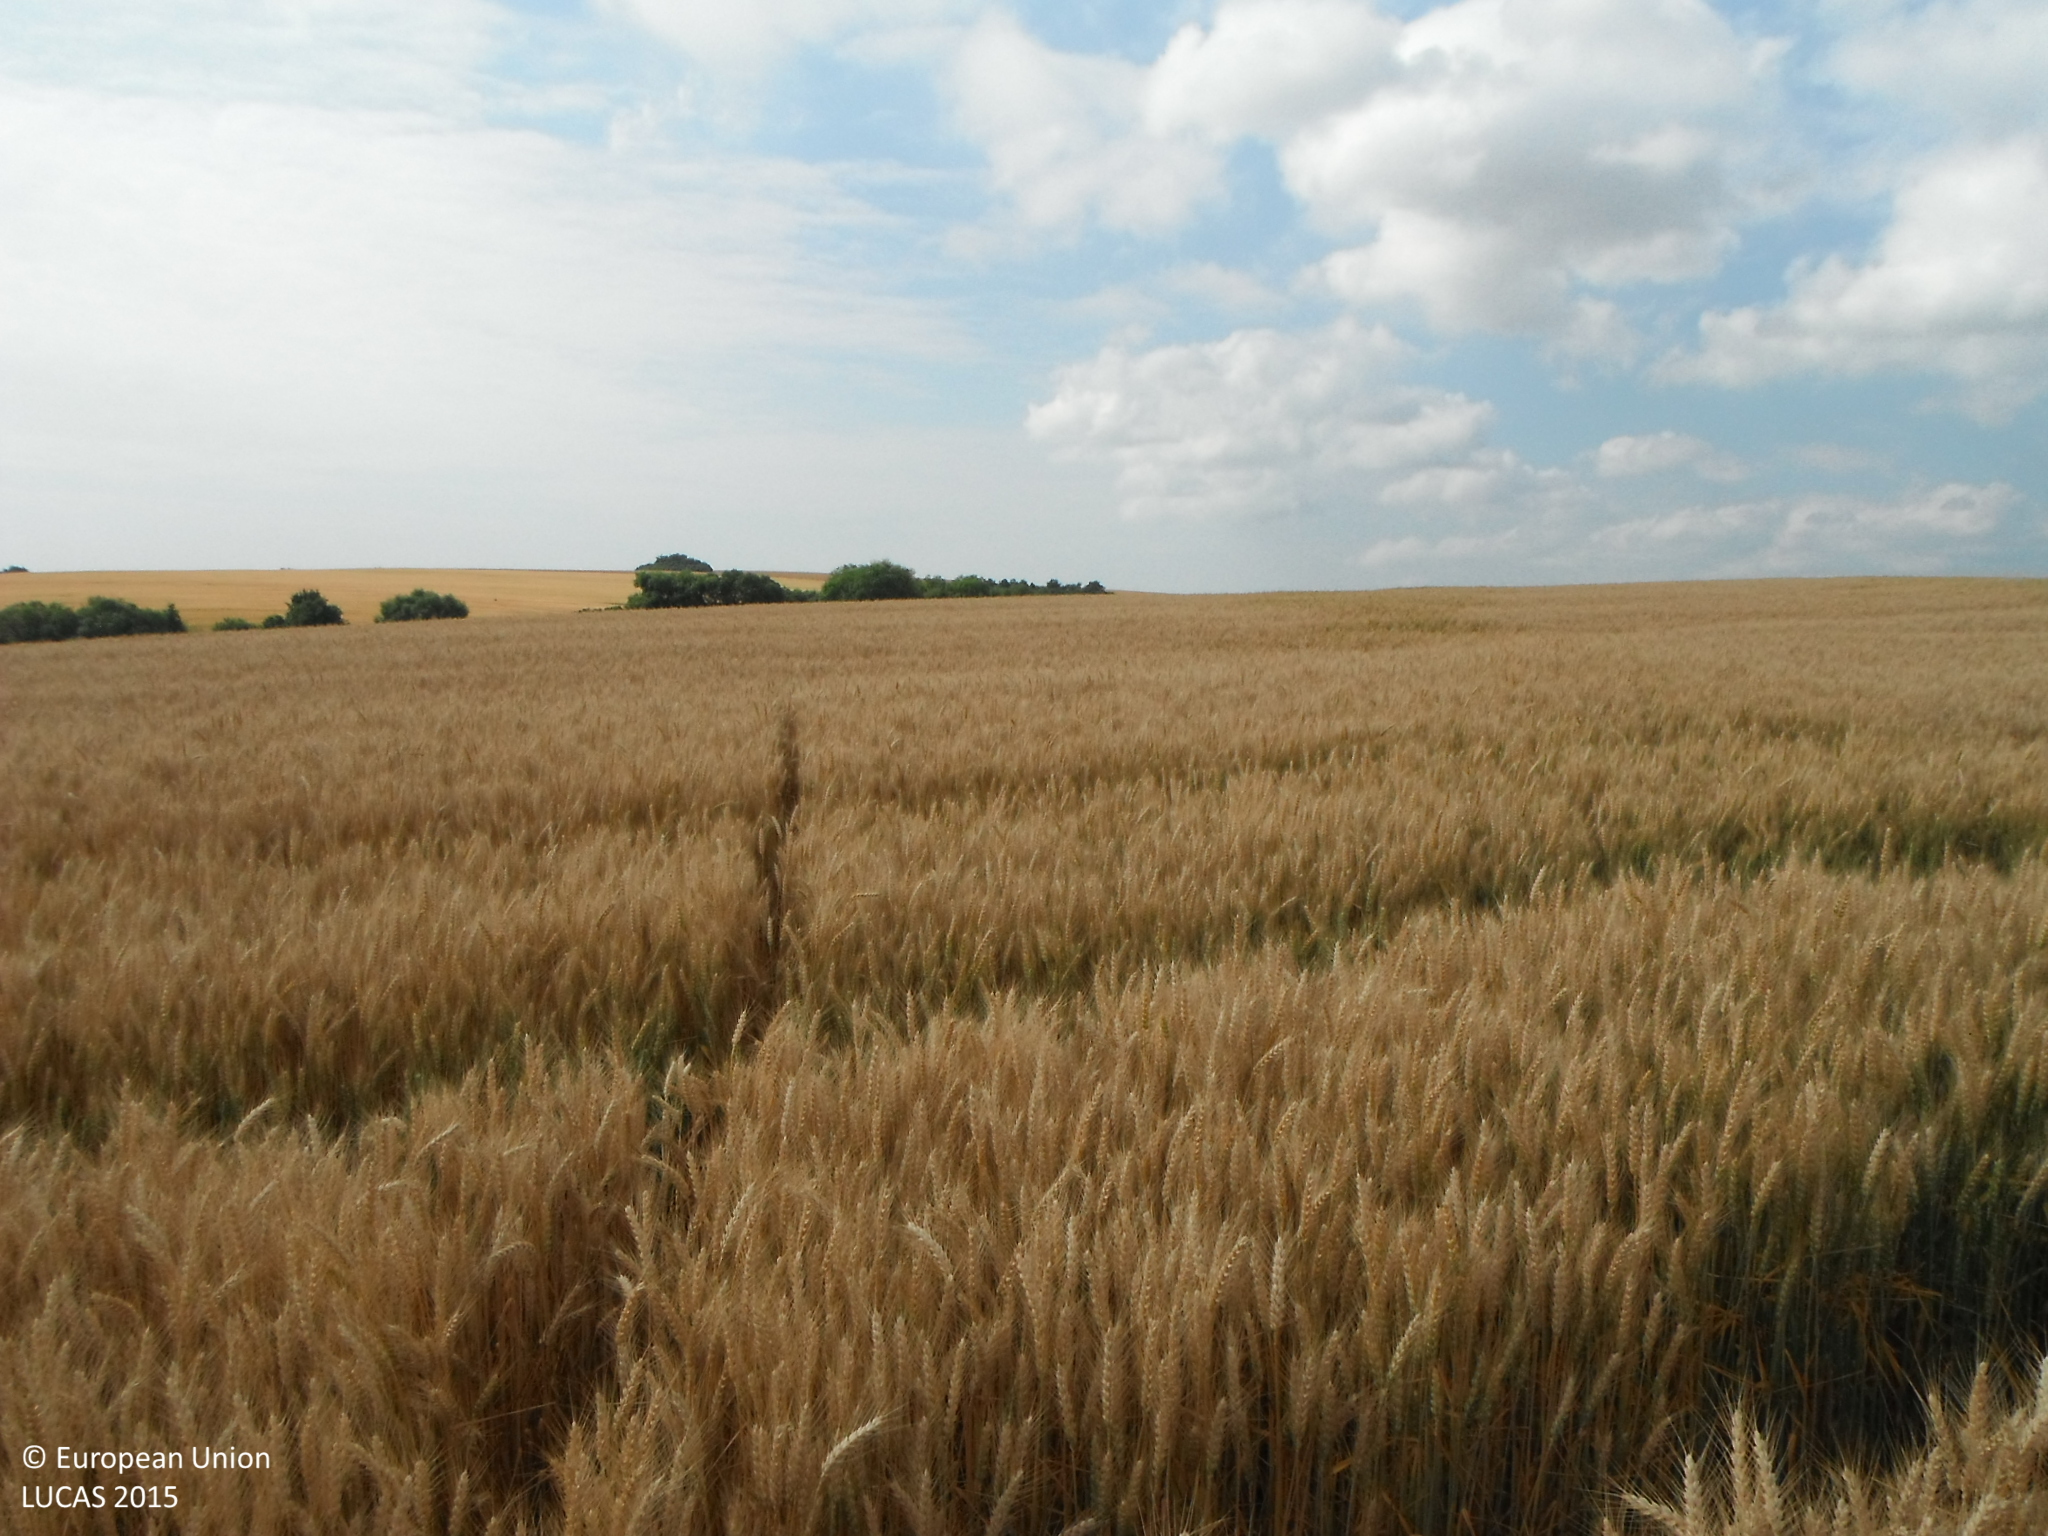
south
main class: Cropland
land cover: Common wheat
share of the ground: > 75 %
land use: Agriculture (excluding fallow land and kitchen gardens)
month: June
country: SK
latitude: 48.6301
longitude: 21.5680
